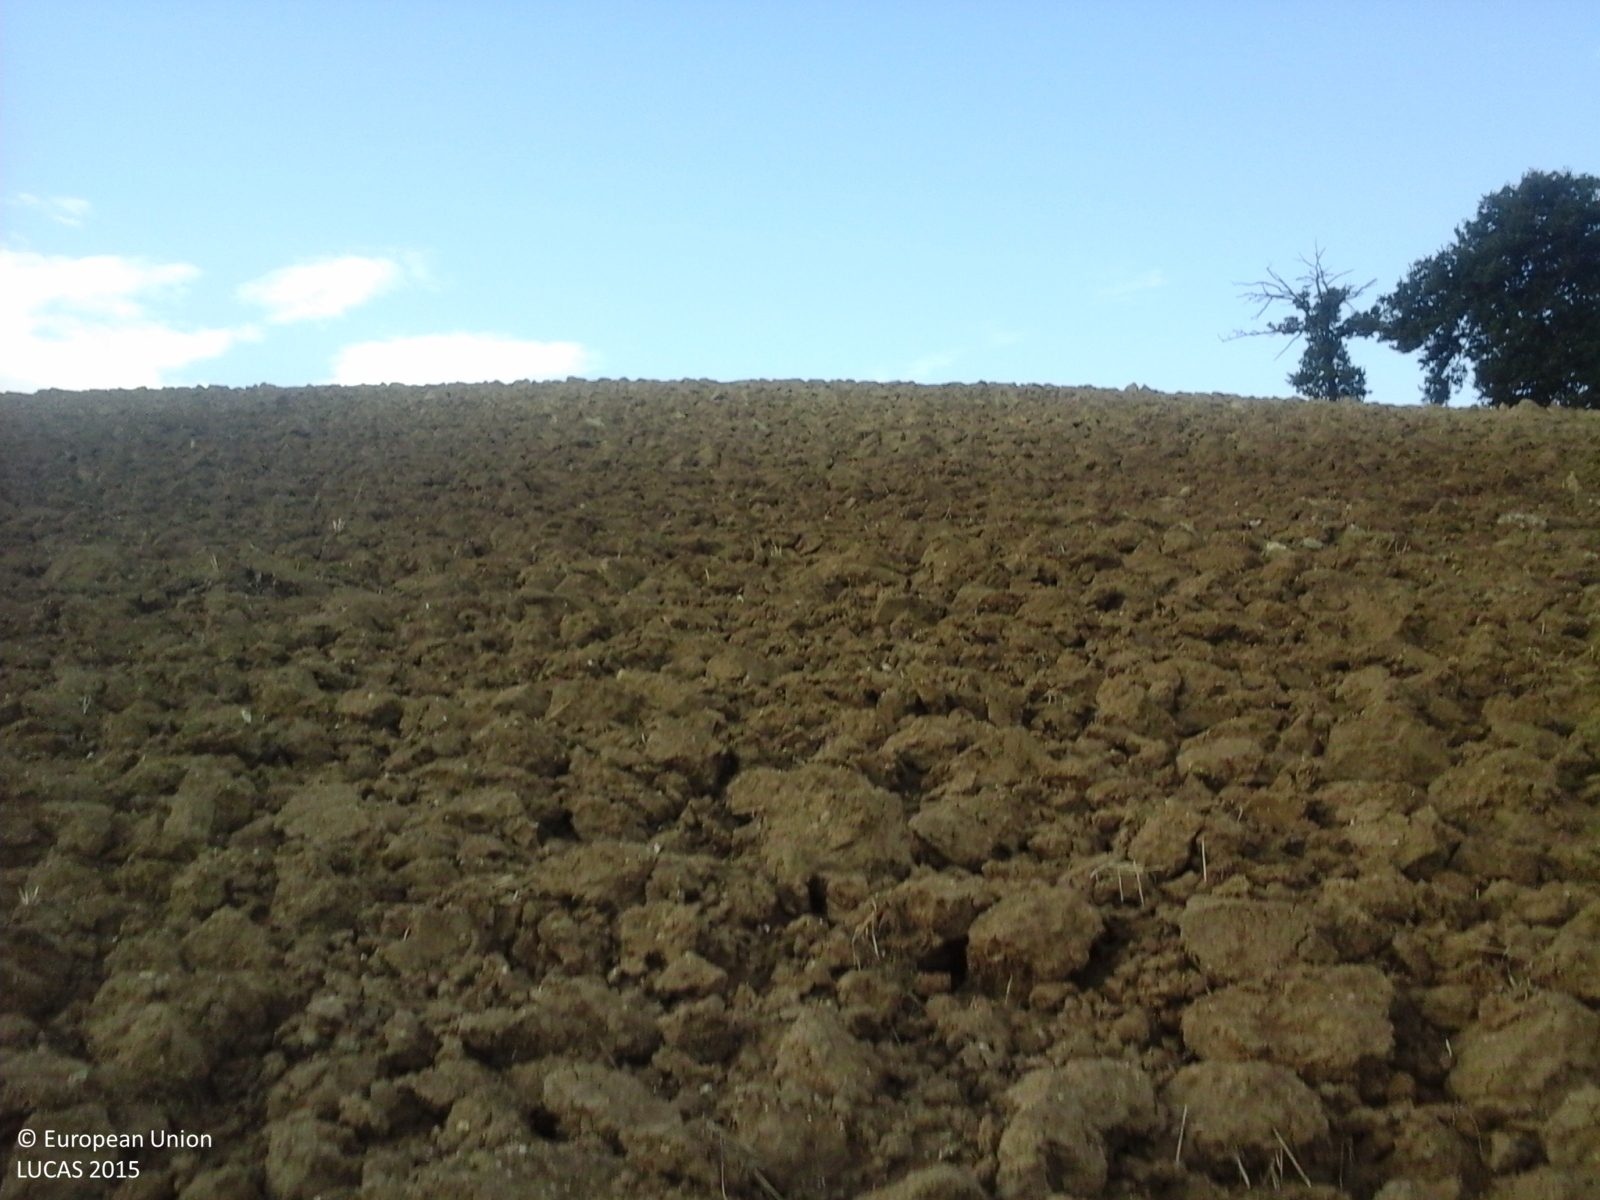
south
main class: Cropland
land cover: Common wheat
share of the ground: < 10 %
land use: Agriculture (excluding fallow land and kitchen gardens)
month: August
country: IT
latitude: 43.6621
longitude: 12.8328
